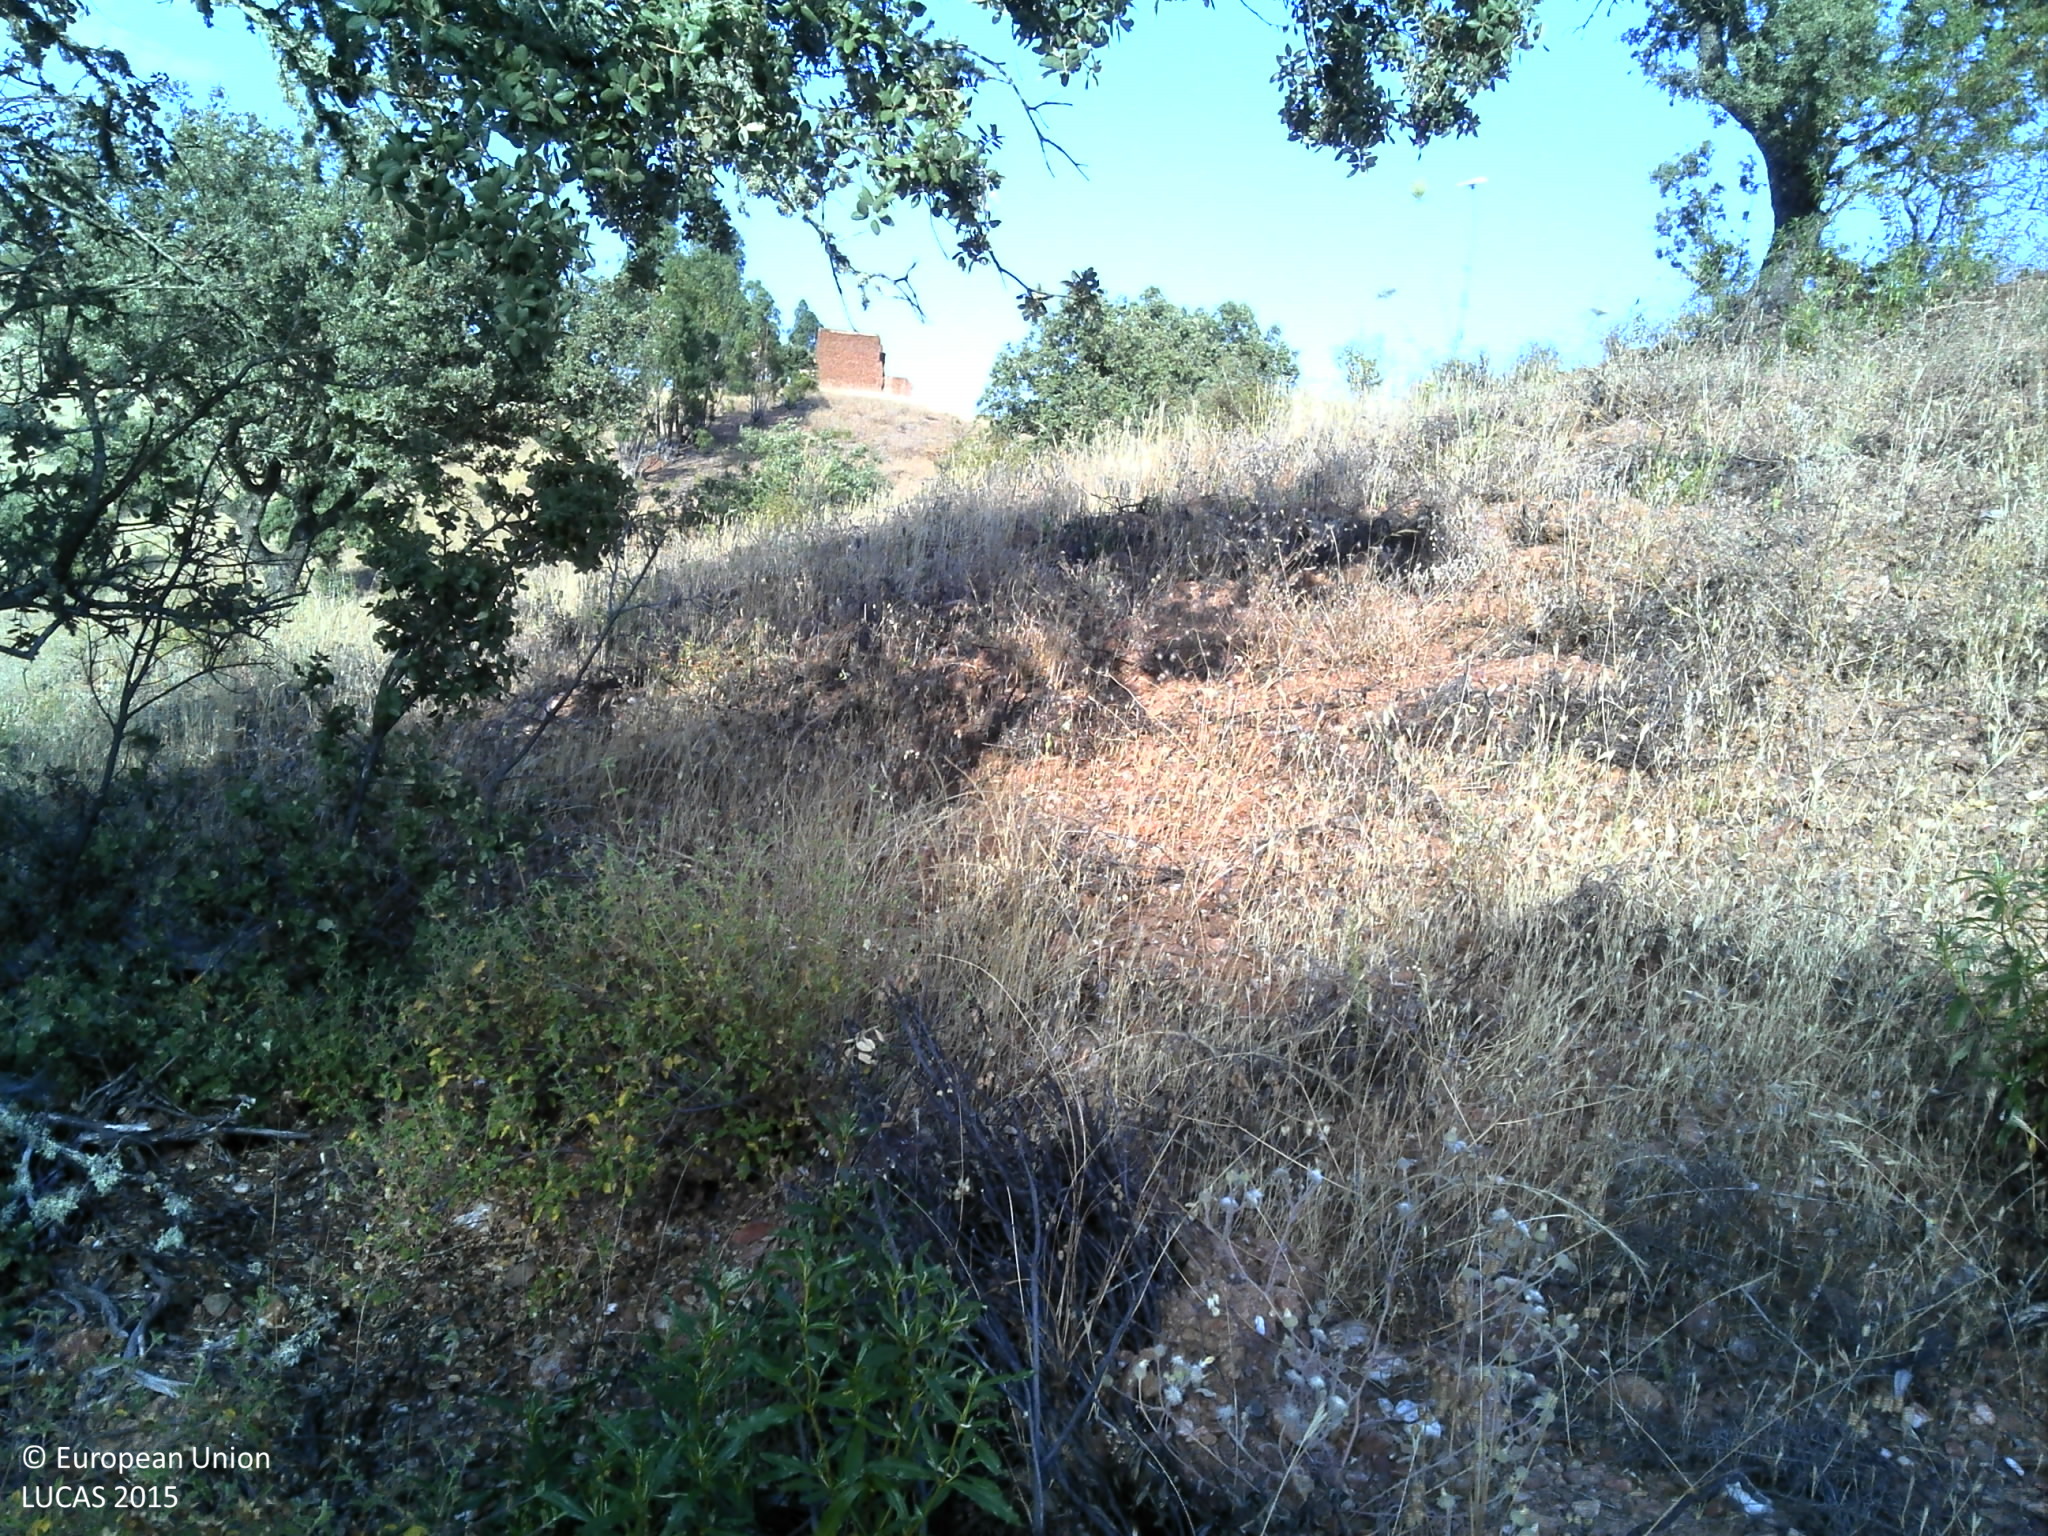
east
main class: Woodland
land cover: Broadleaved woodland
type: broadleaved evergreen forest
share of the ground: 25 - 50 %
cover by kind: herbaceous plants 50 %, broadleaved forest trees 25 %, unconsolidated bare surface 15 %, shrubs 10 %
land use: Forestry
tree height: < 5 m
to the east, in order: Broadleaved woodland; Grass margins; Rivers and streams; Grass margins; Grassland with sparse tree/shrub cover; Grassland without tree/shrub cover; Artificial constructions in urban areas; Grassland without tree/shrub cover; Single bushes/trees; Shruby margins; Other bare soil; Shruby margins; Fences; Shruby margins; Tracks; Other bare soil; Shruby margins; Fences; Other bare soil; Broadleaved woodland
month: June
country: PT
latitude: 37.7528
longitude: -7.6207
